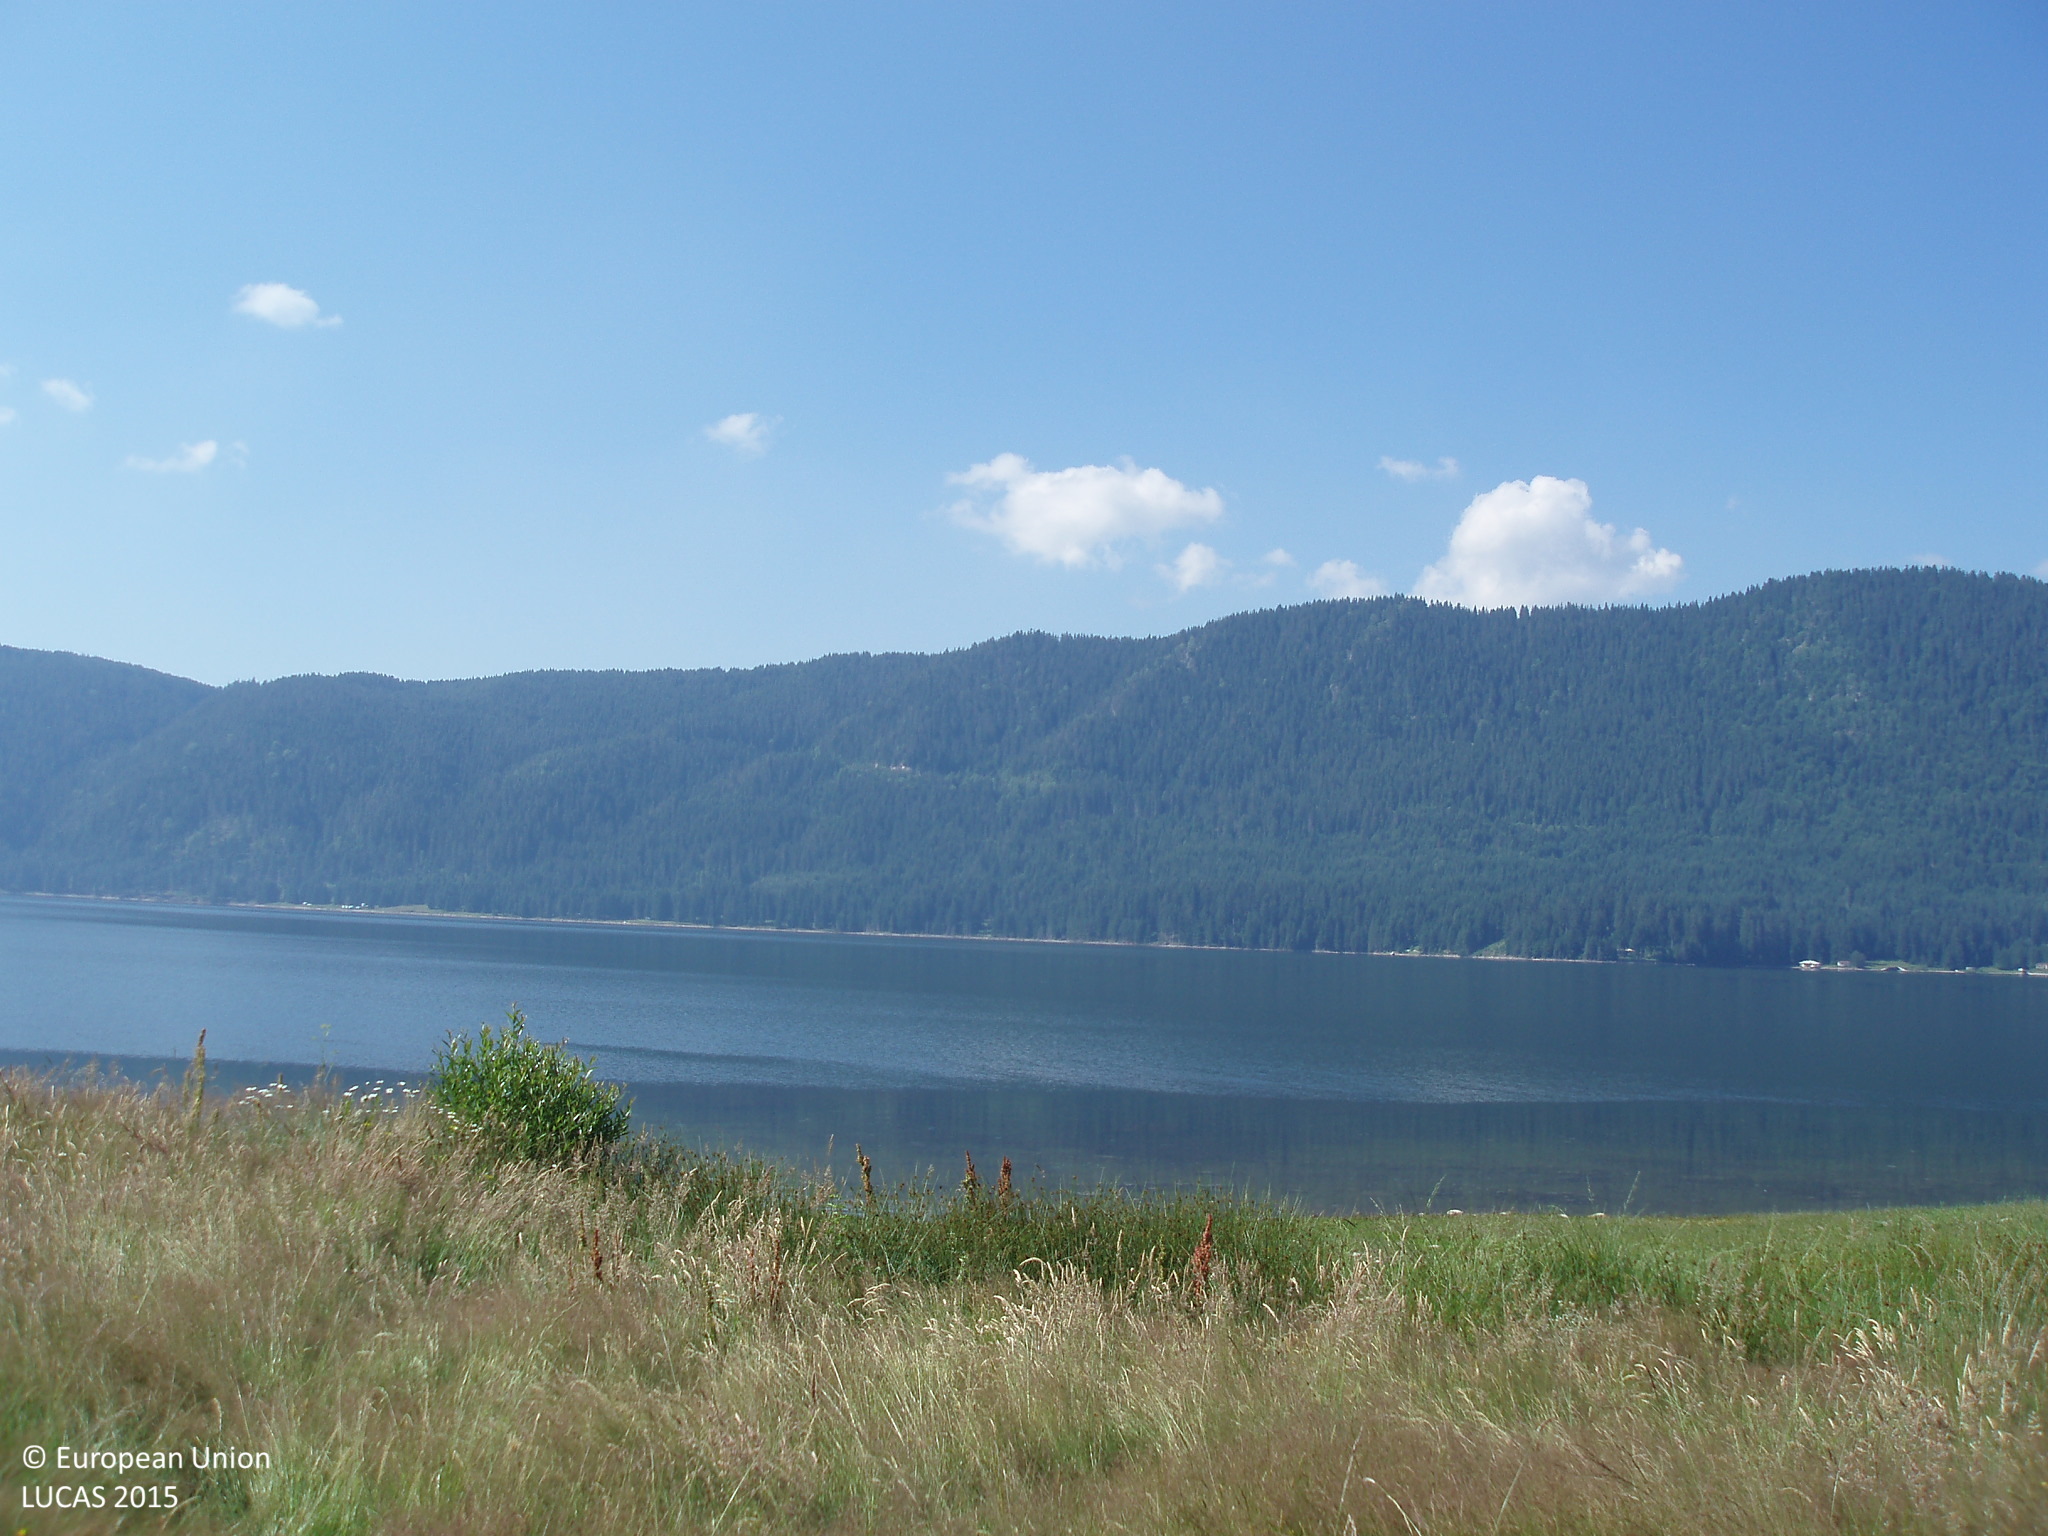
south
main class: Grassland
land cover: Grassland without tree/shrub cover
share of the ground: > 75 %
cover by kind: herbaceous plants 100 %
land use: Agriculture (excluding fallow land and kitchen gardens)
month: July
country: BG
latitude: 41.7223
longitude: 24.0631
